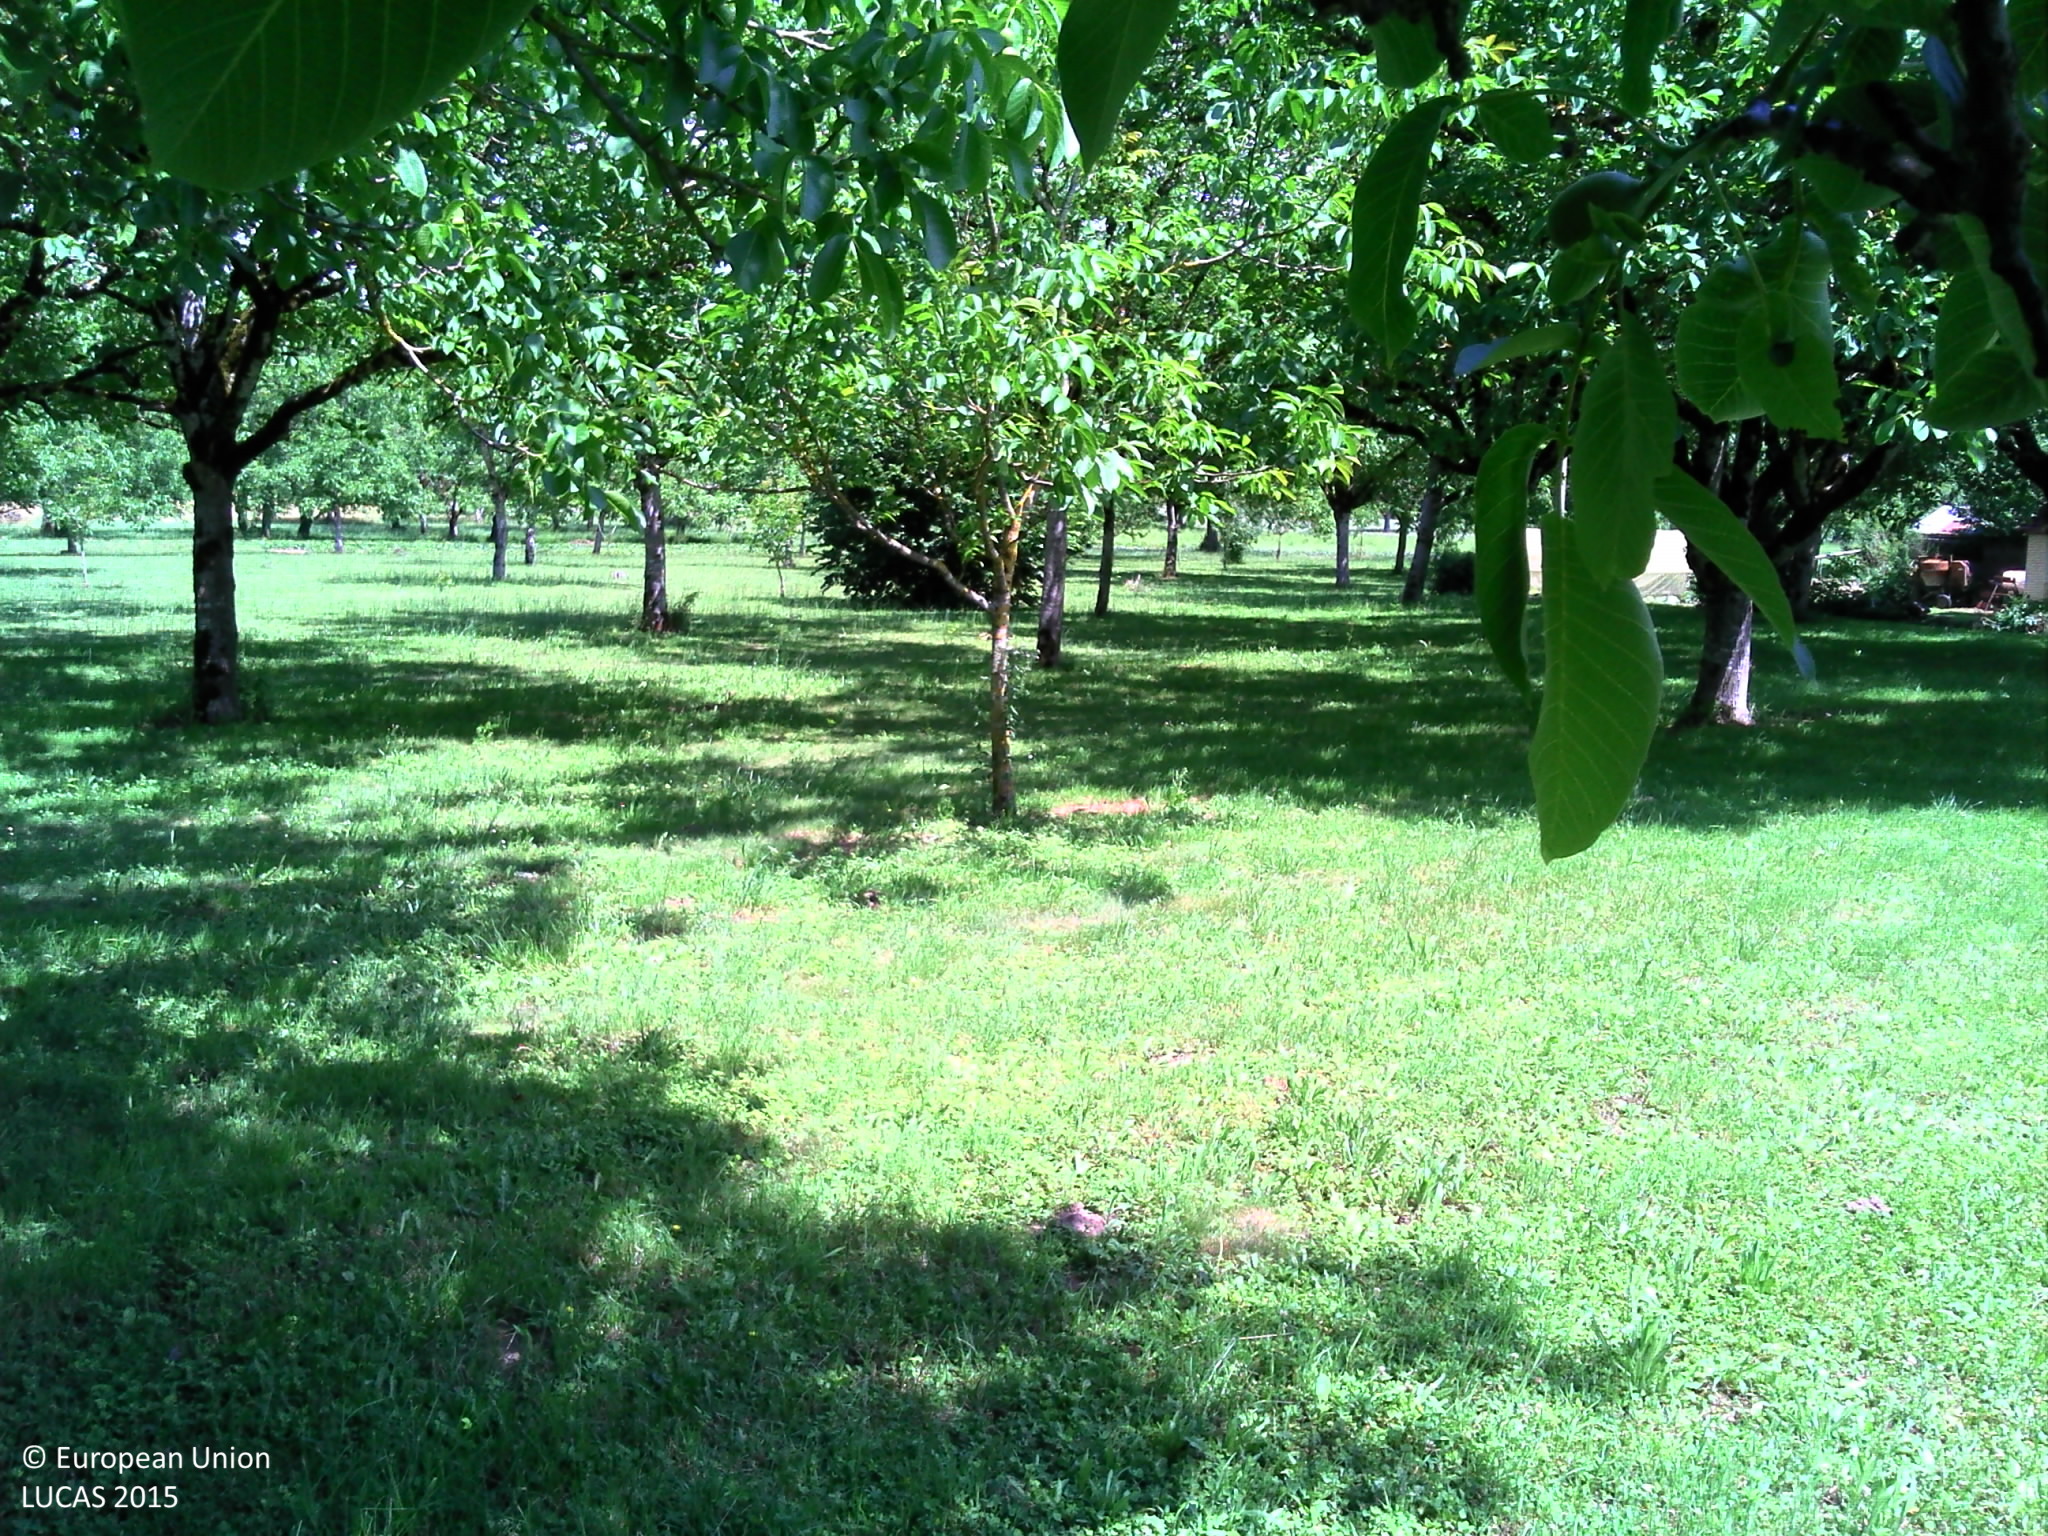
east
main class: Cropland
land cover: Nuts trees
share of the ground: 50 - 75 %
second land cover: Grassland without tree/shrub cover
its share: 10 - 25 %
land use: Agriculture (excluding fallow land and kitchen gardens)
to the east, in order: Nuts trees; Grassland without tree/shrub cover; Other fresh vegetables; Maize; Grass margins; Nuts trees; Grass margins; Maize
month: June
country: FR
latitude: 44.9275
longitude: 1.7494
